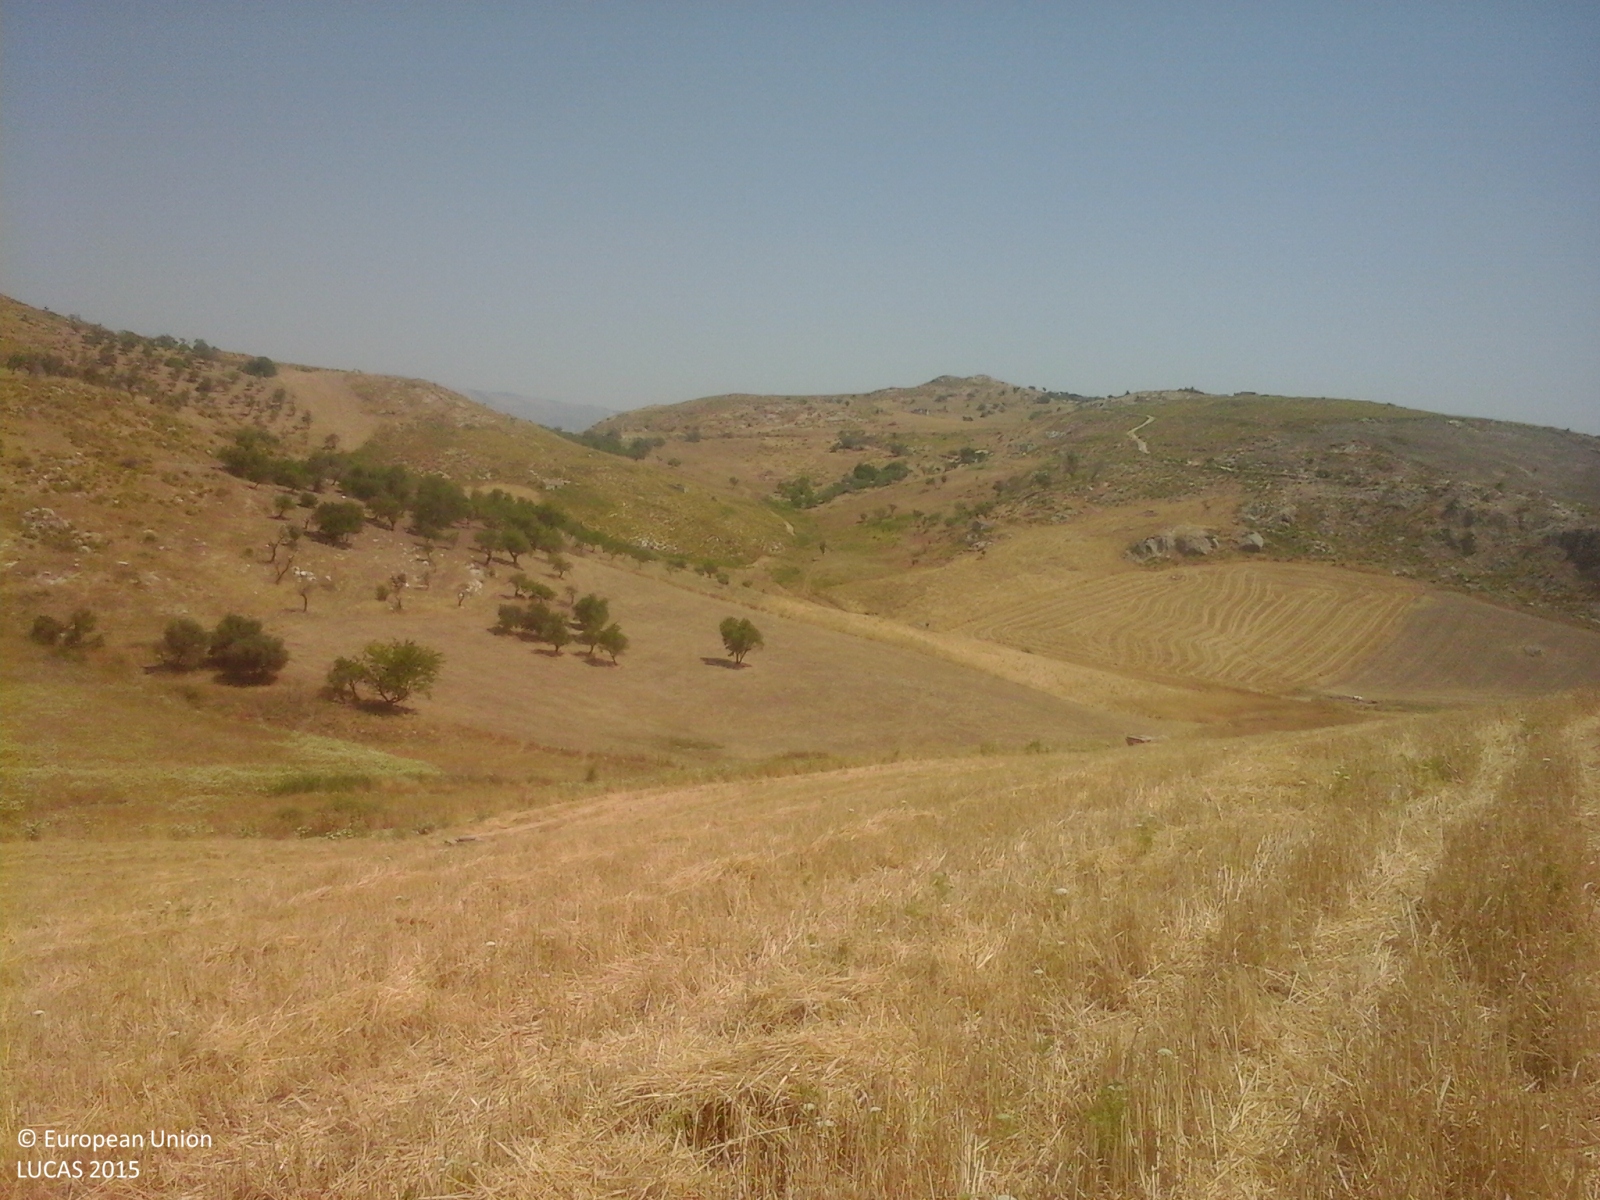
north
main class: Cropland
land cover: Durum wheat
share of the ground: > 75 %
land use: Agriculture (excluding fallow land and kitchen gardens)
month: July
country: IT
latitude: 37.4646
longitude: 13.5120
